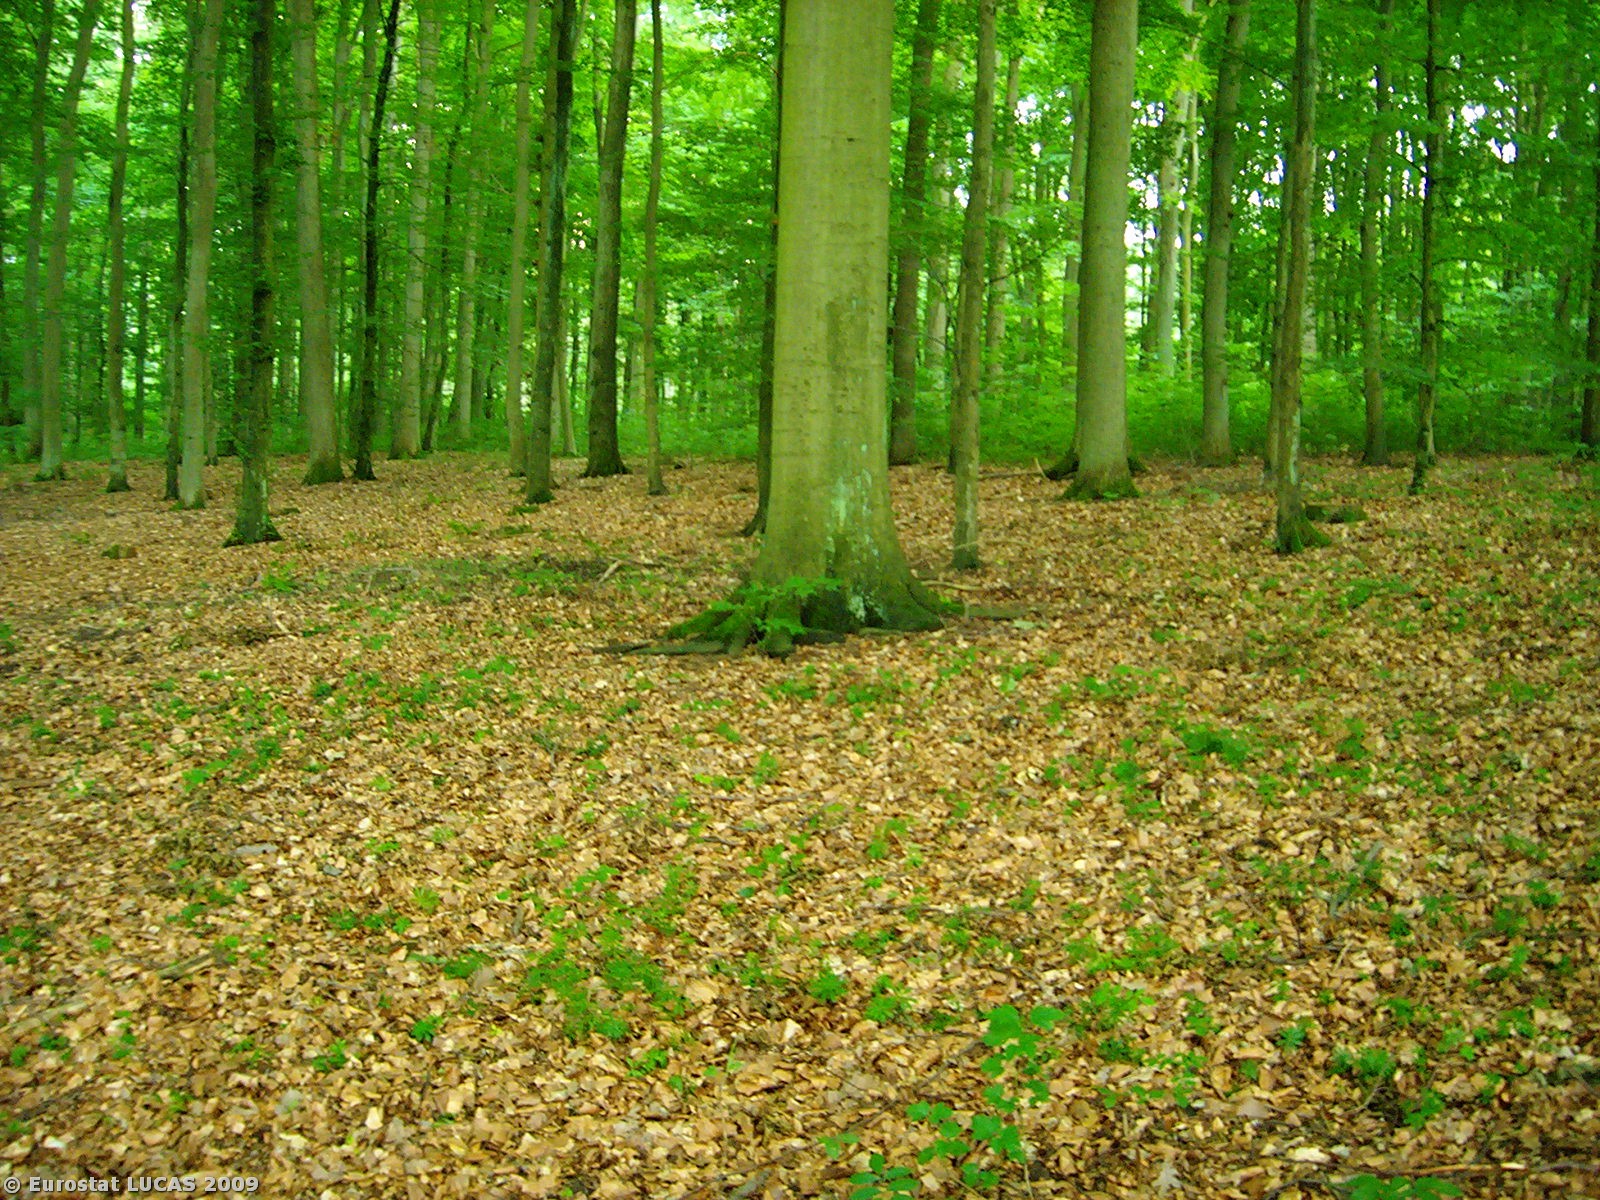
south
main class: Woodland
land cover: Broadleaved woodland
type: hemiboreal forest and nemoral coniferous forest and mixed broadleaved-coniferous forest
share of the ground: > 75 %
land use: Forestry
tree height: > 5 m
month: July
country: PL
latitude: 53.3497
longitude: 15.4865
